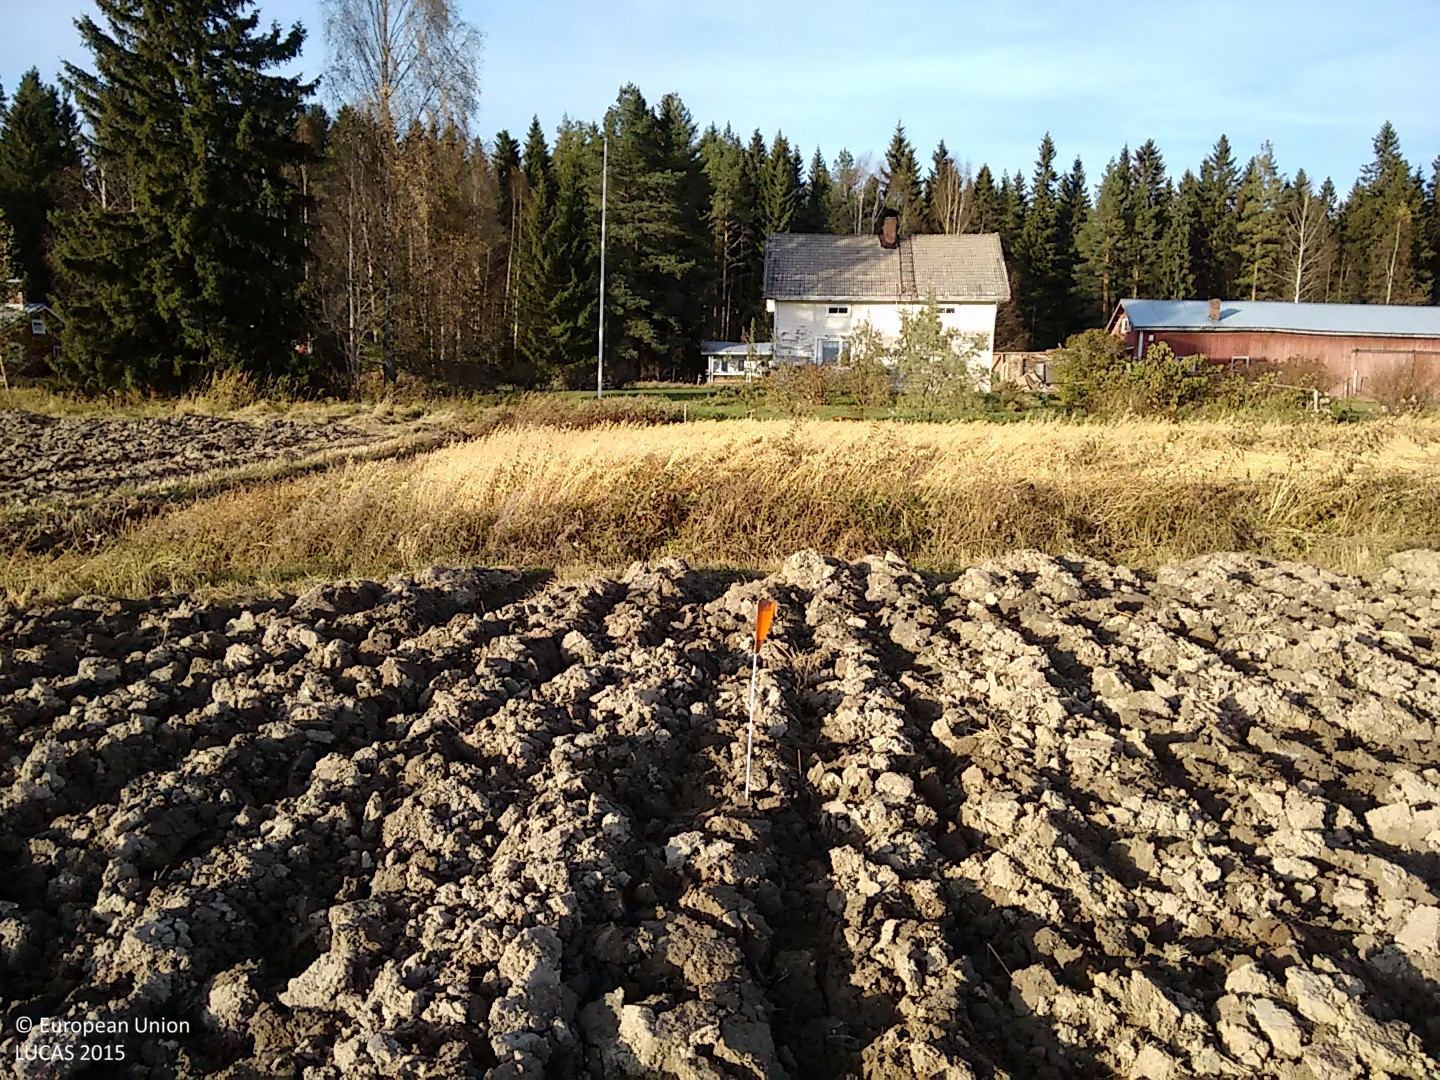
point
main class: Cropland
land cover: Barley
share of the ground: < 10 %
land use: Agriculture (excluding fallow land and kitchen gardens)
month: October
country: FI
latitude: 63.9615
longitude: 25.1360
